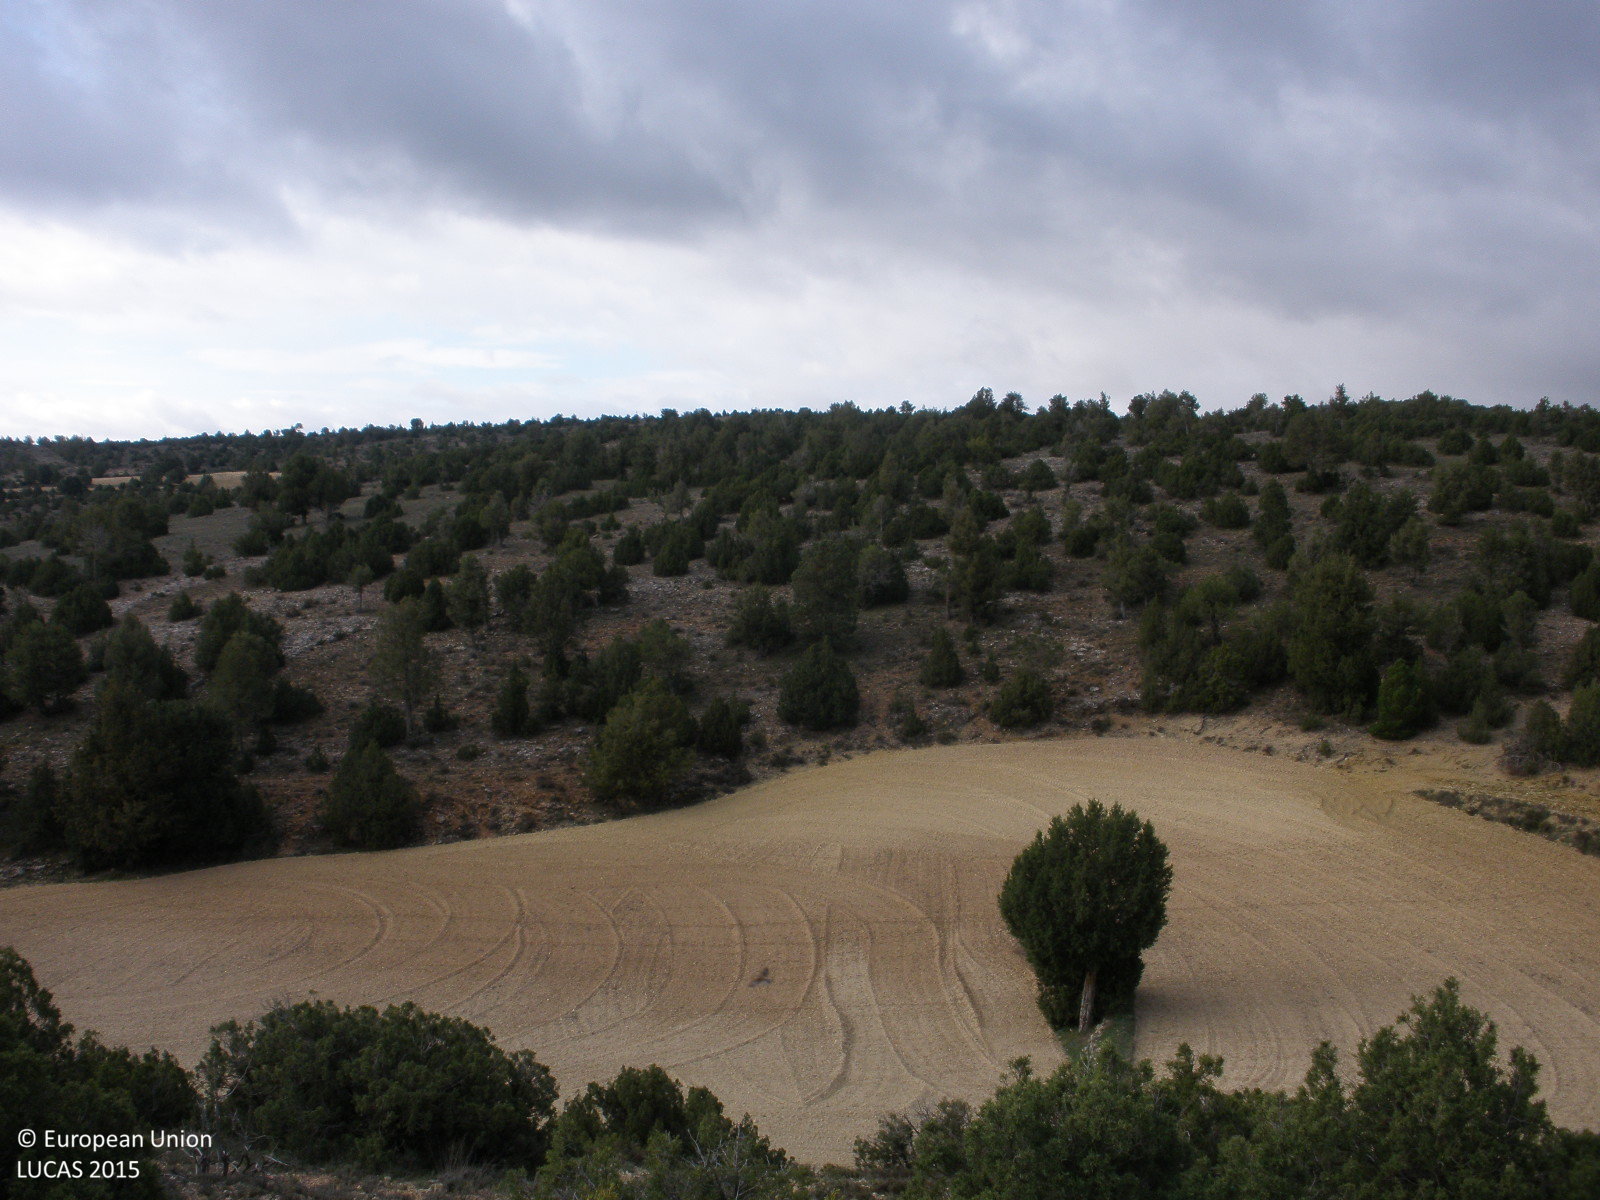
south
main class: Woodland
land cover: Other coniferous woodland
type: coniferous forest of the mediterranean region
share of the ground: > 75 %
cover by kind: coniferous forest trees 40 %, shrubs 30 %, consolidated bare surface 30 %
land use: Semi-natural and natural areas not in use
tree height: < 5 m
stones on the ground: > 50 %
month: April
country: ES
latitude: 40.3475
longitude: -1.2551
